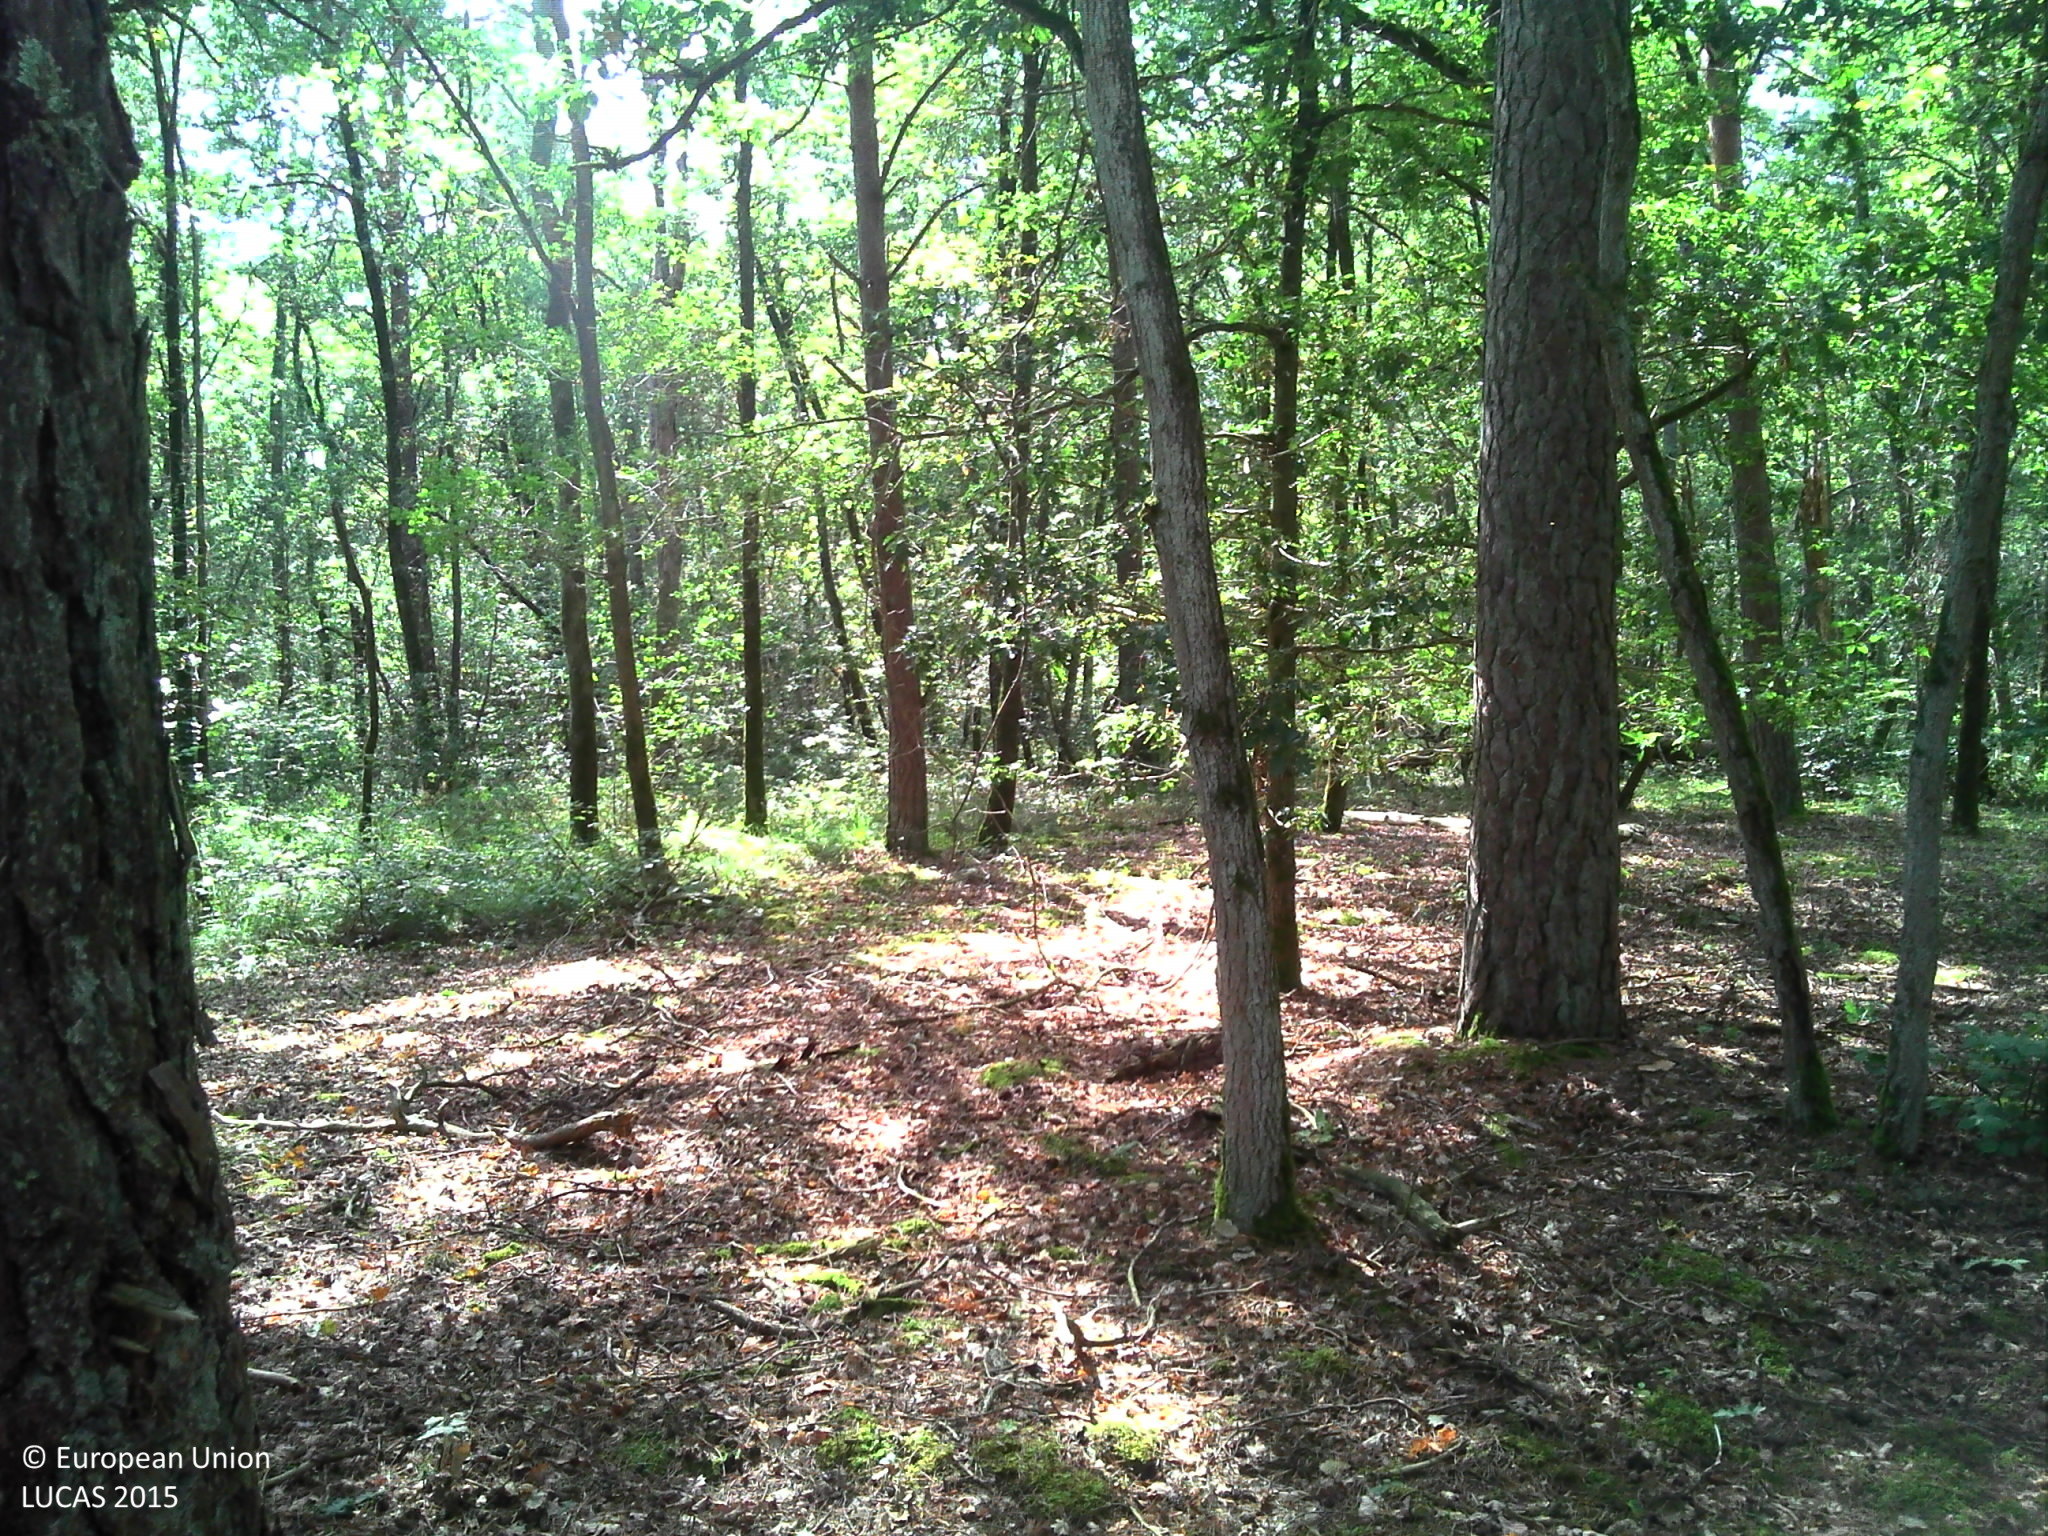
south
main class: Woodland
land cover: Pine dominated mixed woodland
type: acidophilous oak and oak-birch forest
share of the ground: > 75 %
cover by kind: coniferous forest trees 50 %, broadleaved forest trees 40 %, herbaceous plants 5 %, lichens and mosses 5 %
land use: Forestry
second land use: Amenities, museums, leisure
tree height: > 5 m
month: September
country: FR
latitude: 48.2383
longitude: 2.7608
